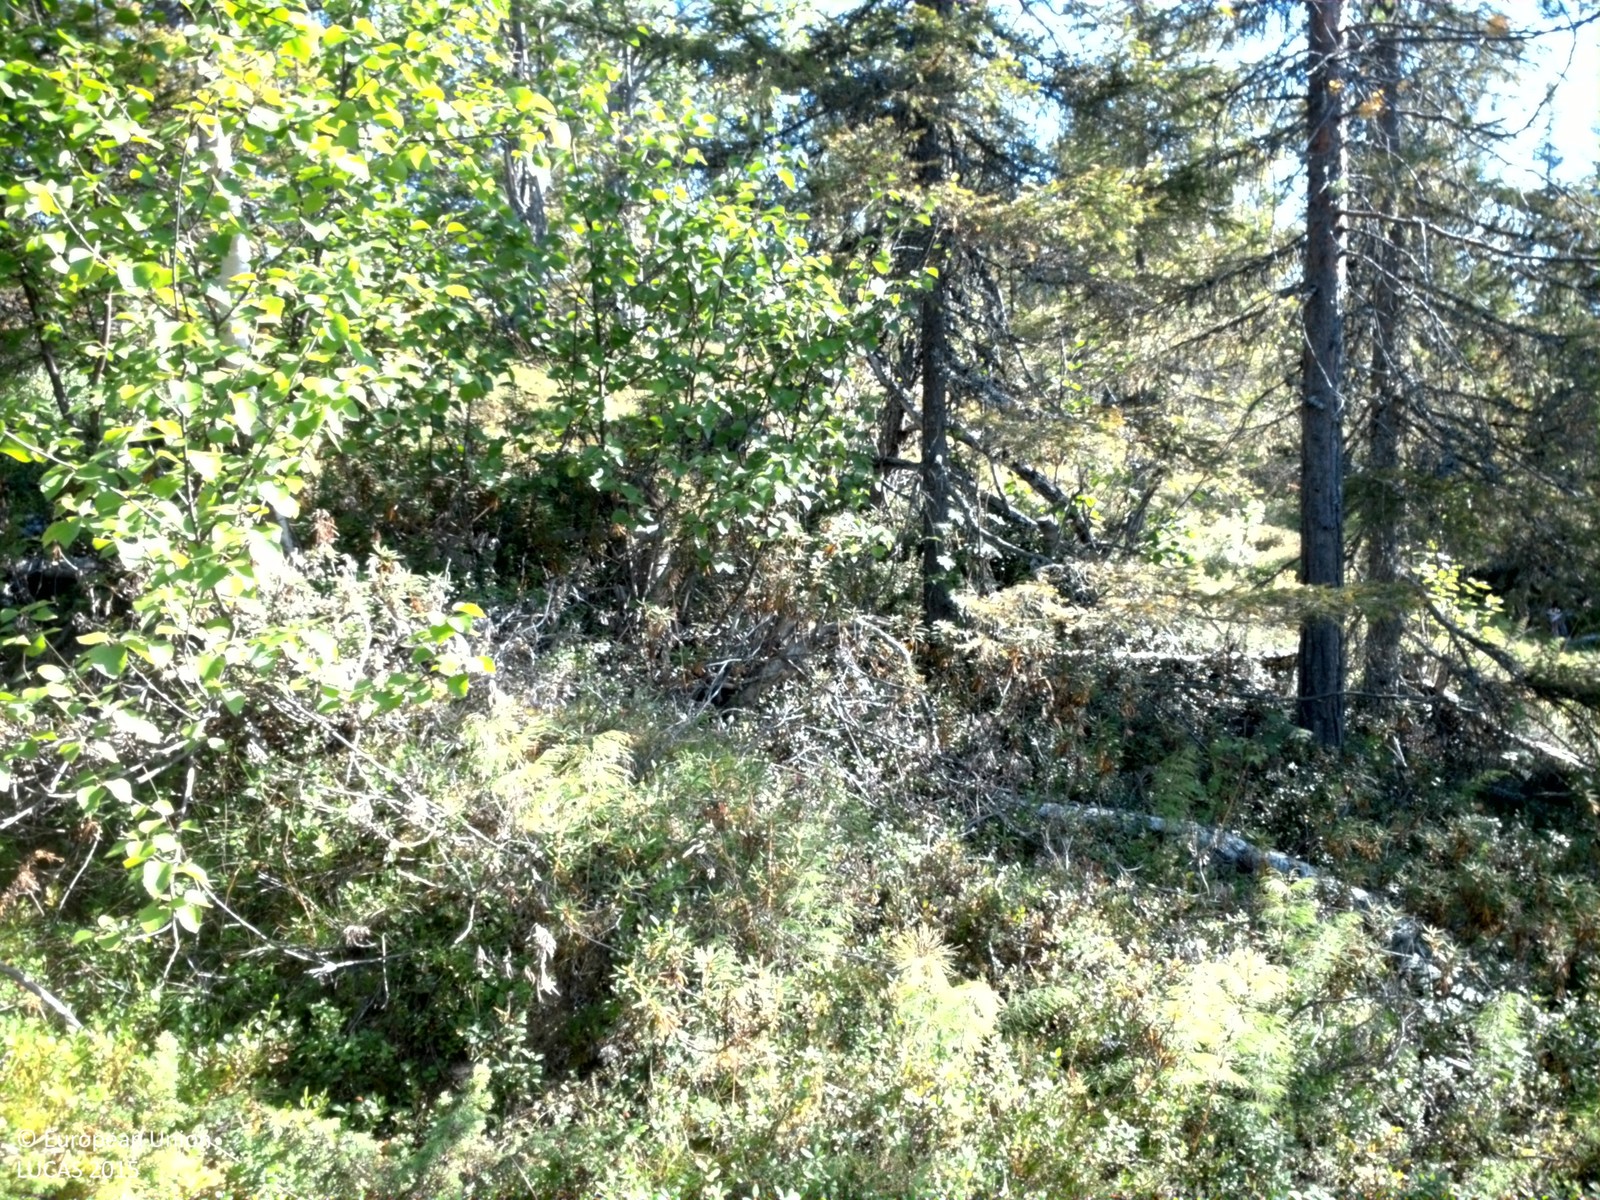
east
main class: Woodland
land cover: Spruce dominated mixed woodland
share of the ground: 25 - 50 %
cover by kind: shrubs 60 %, coniferous forest trees 20 %, broadleaved forest trees 10 %, lichens and mosses 10 %
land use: Forestry
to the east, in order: Spruce dominated mixed woodland; Pine dominated mixed woodland; Broadleaved woodland; Shruby margins; Paved roads, cycling and walking lanes; Shruby margins; Broadleaved woodland; Spruce dominated mixed woodland; Peatbogs
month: August
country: SE
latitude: 66.6949
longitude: 20.8510
